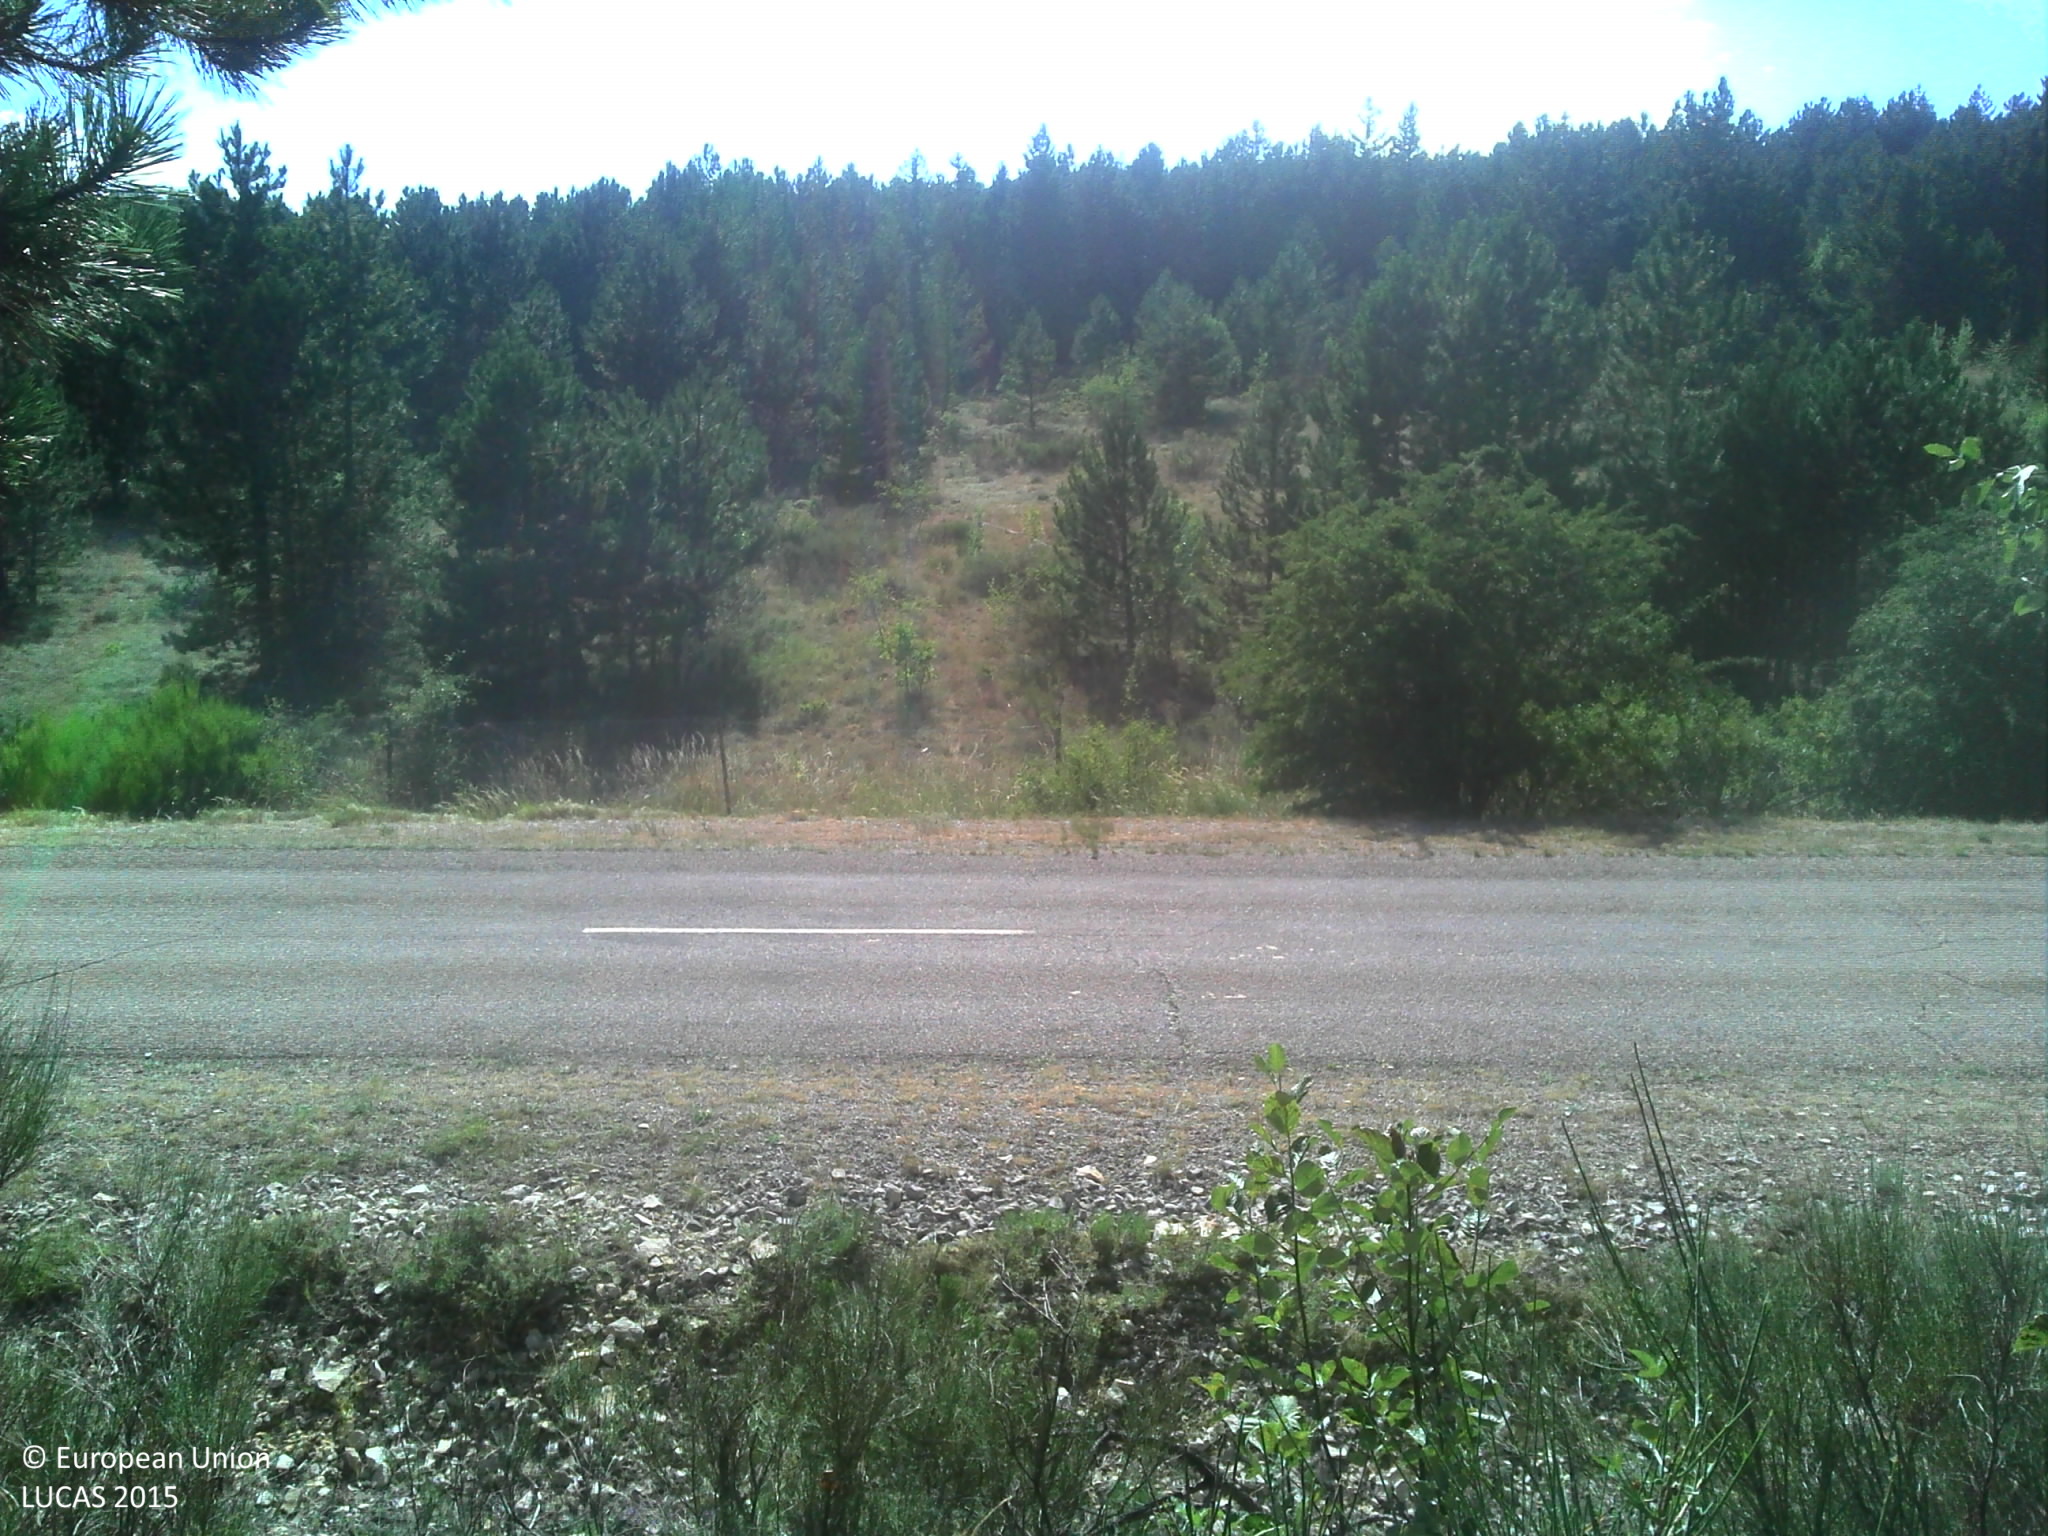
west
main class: Woodland
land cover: Pine dominated coniferous woodland
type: coniferous forest of the mediterranean region
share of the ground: > 75 %
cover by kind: coniferous forest trees 65 %
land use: Forestry
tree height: > 5 m
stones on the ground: < 10 %
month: July
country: FR
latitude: 44.1476
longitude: 5.5697
